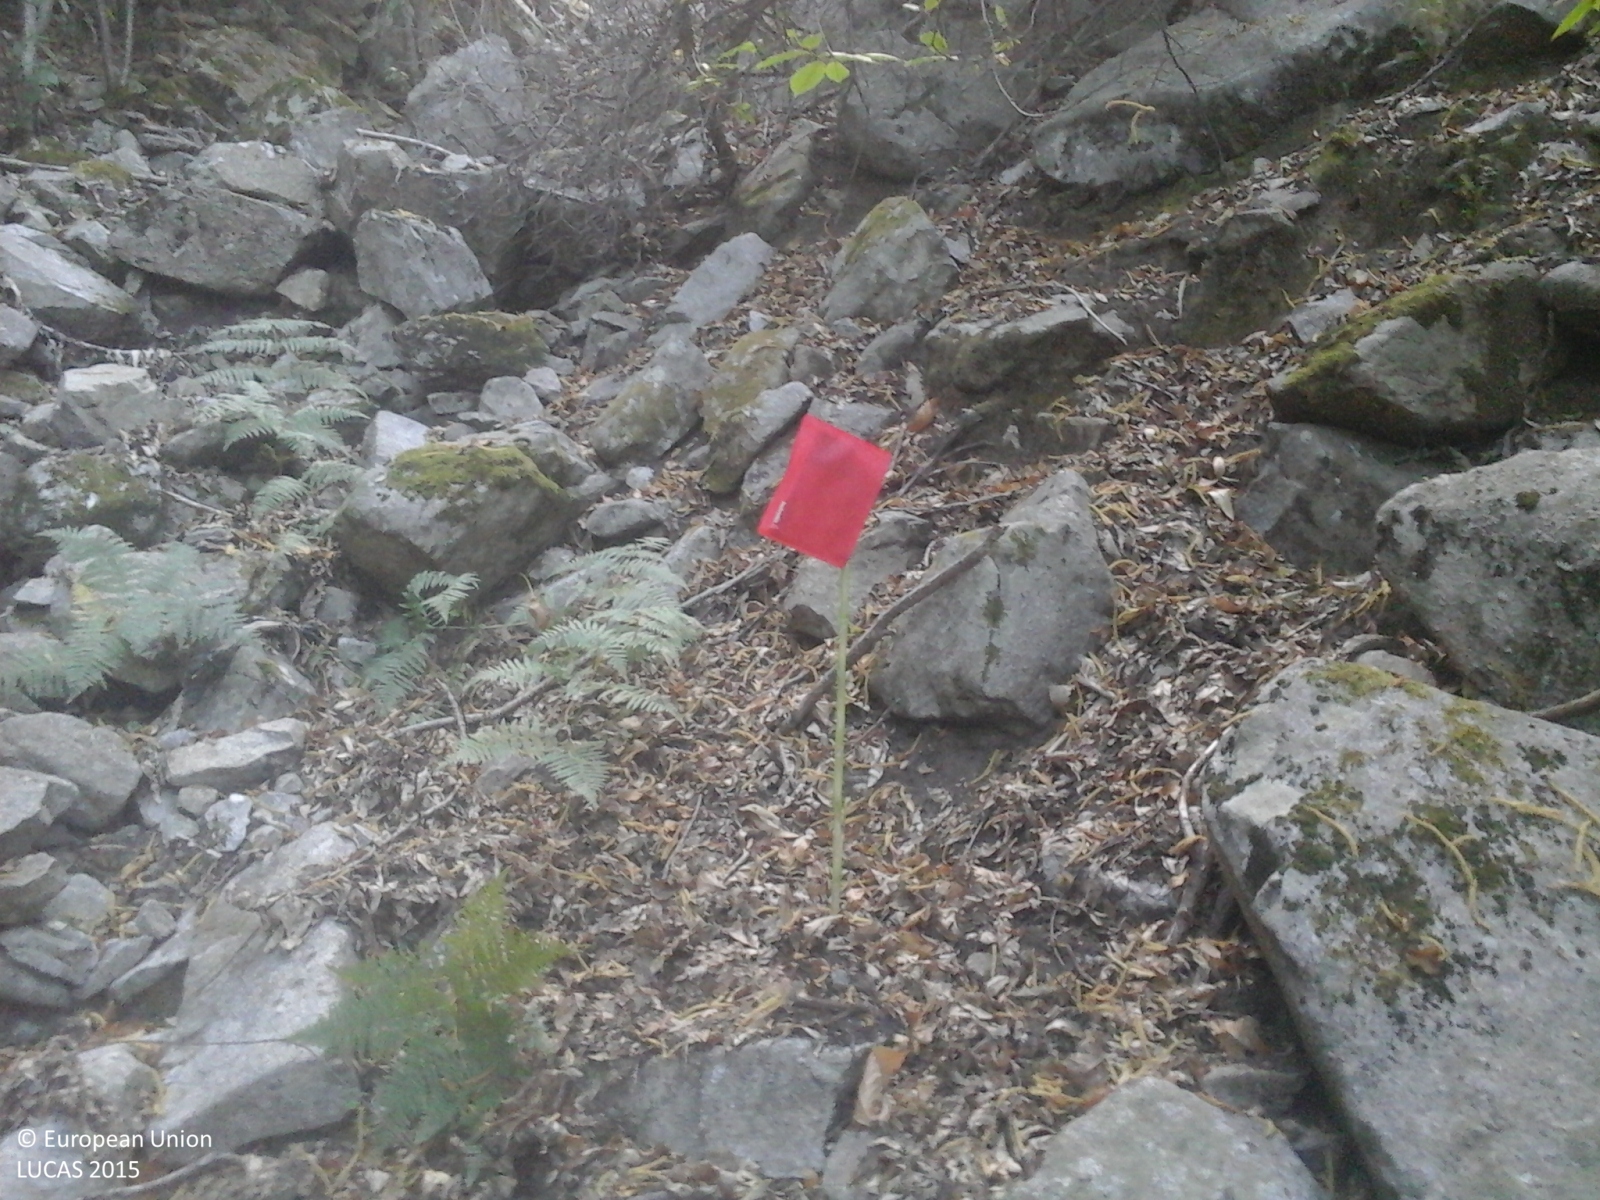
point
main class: Woodland
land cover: Broadleaved woodland
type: thermophilous deciduous forest
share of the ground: > 75 %
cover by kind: broadleaved forest trees 100 %
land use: Forestry
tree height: > 5 m
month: July
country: IT
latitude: 42.7803
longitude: 10.1827
